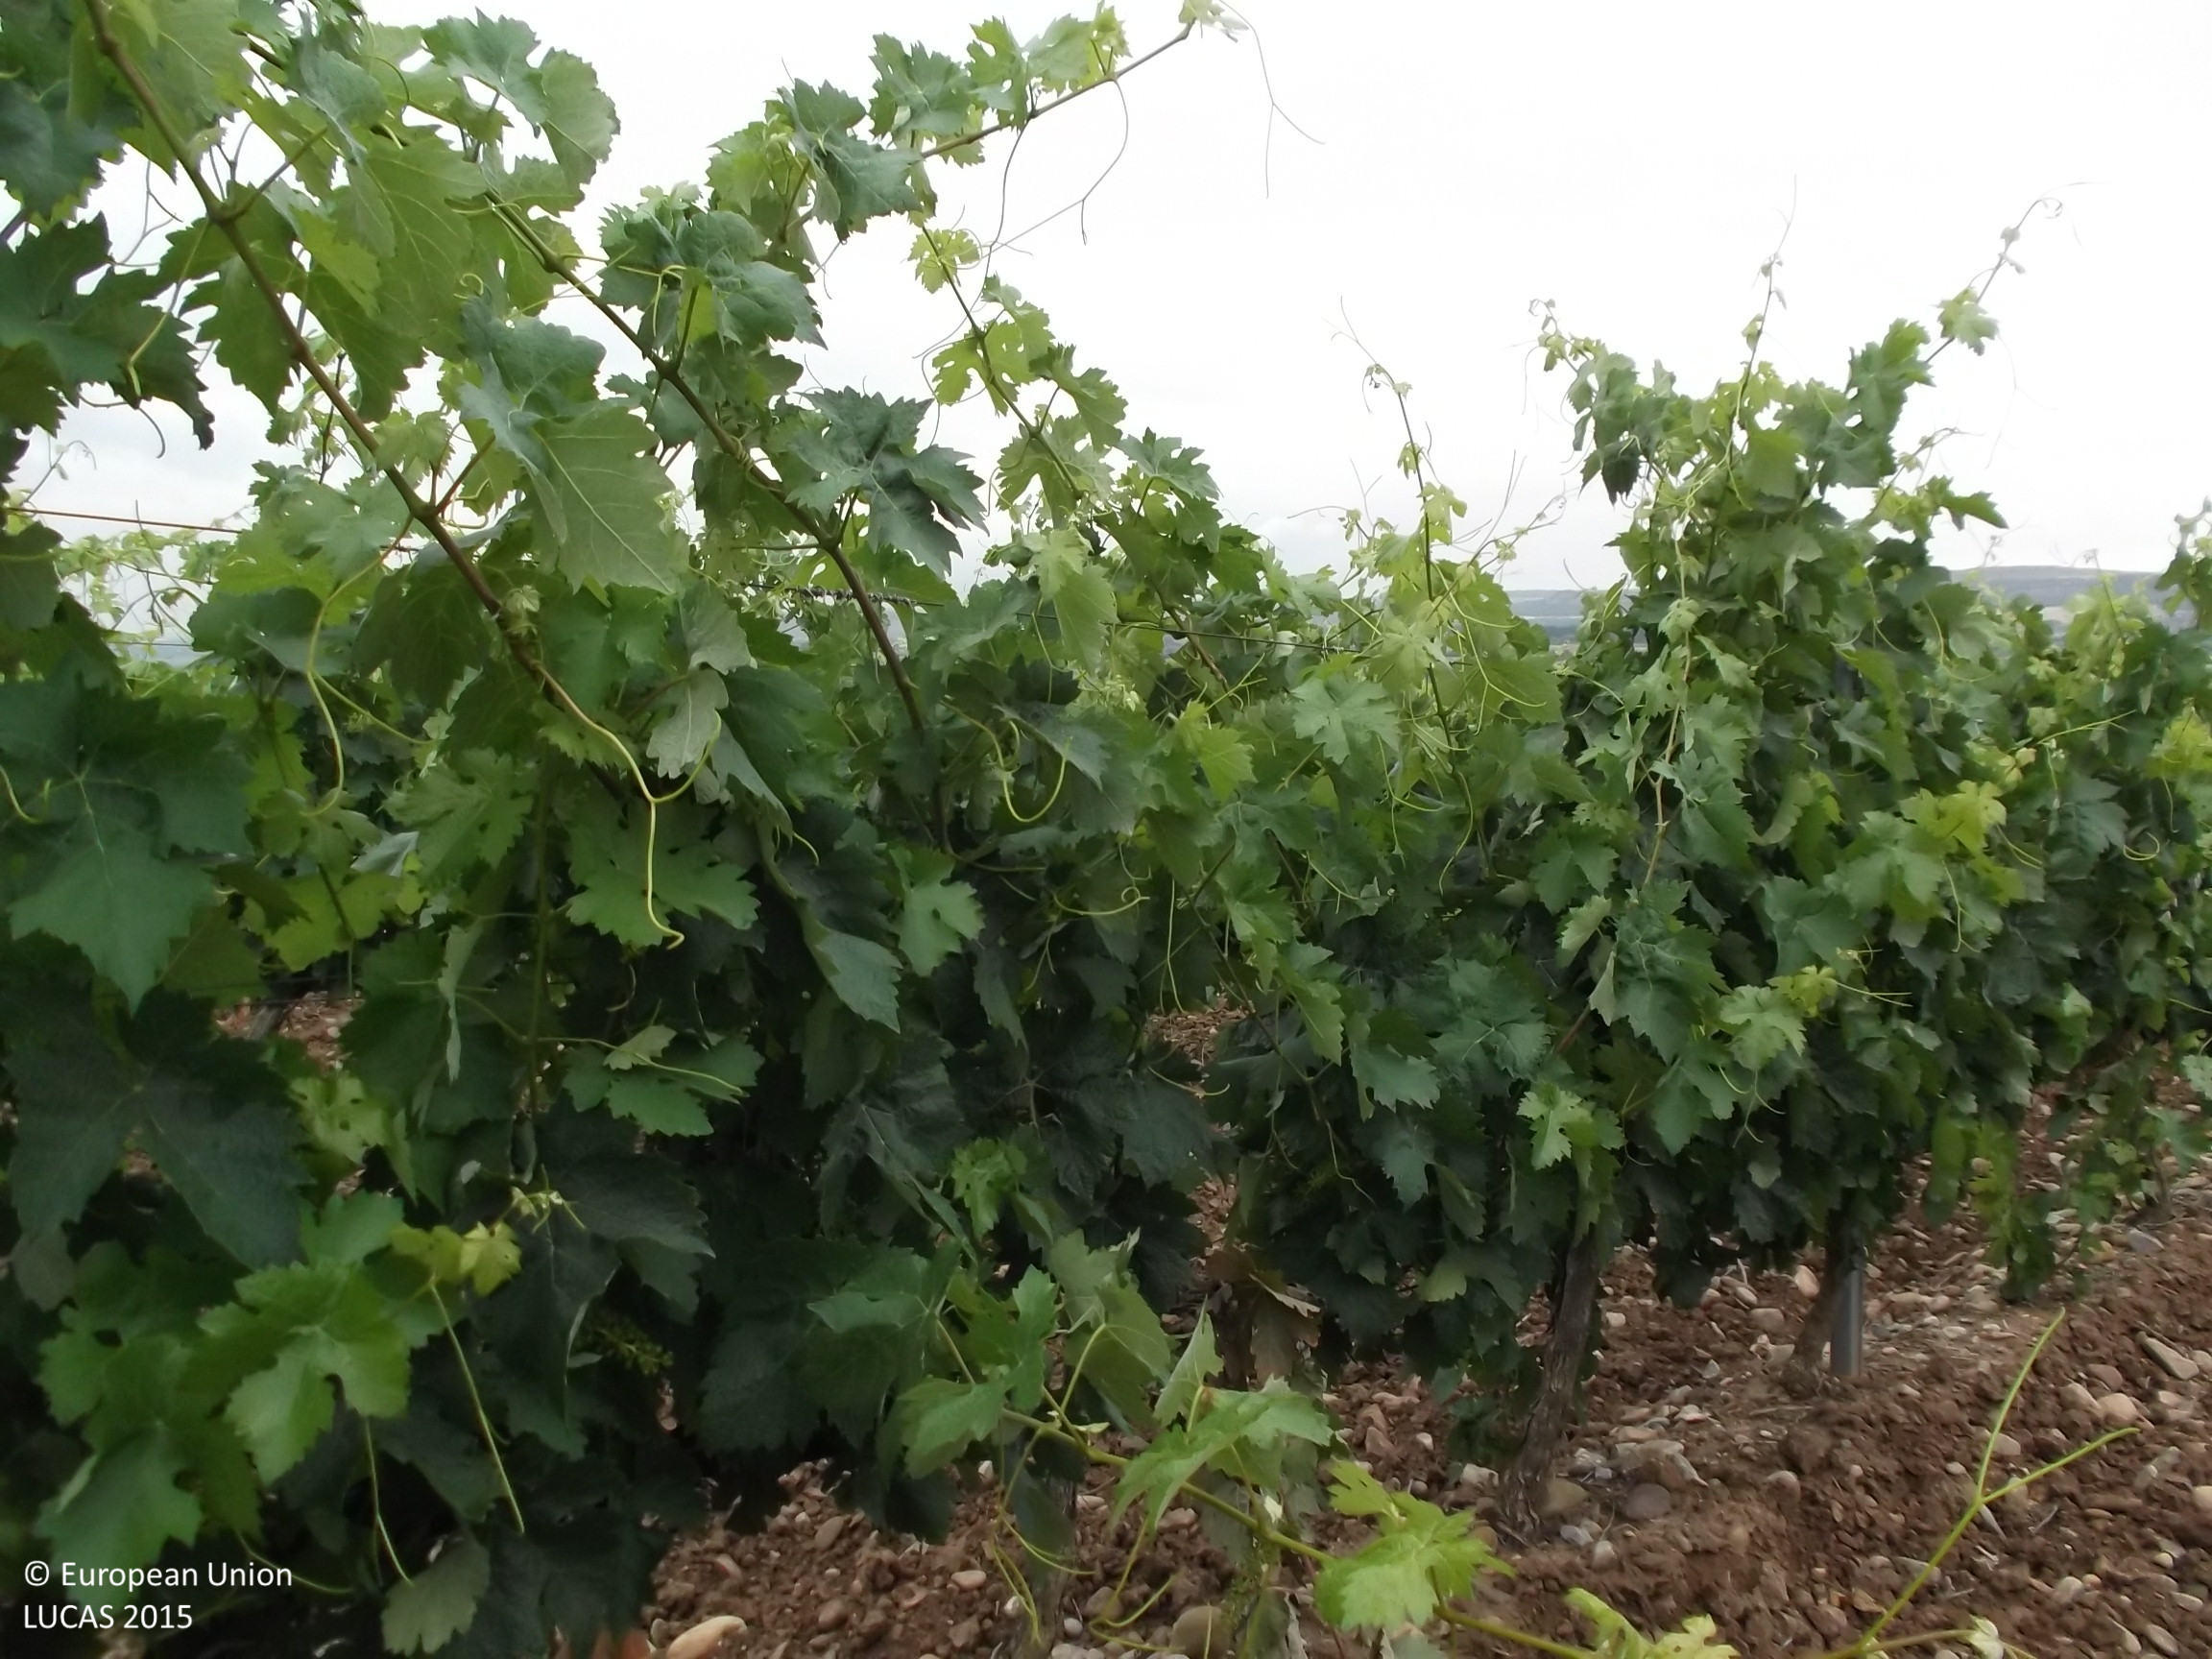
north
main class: Cropland
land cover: Vineyards
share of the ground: 10 - 25 %
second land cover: Other bare soil
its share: > 75 %
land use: Agriculture (excluding fallow land and kitchen gardens)
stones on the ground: 25 - 50 %
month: June
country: ES
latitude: 42.3846
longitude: -2.0767
